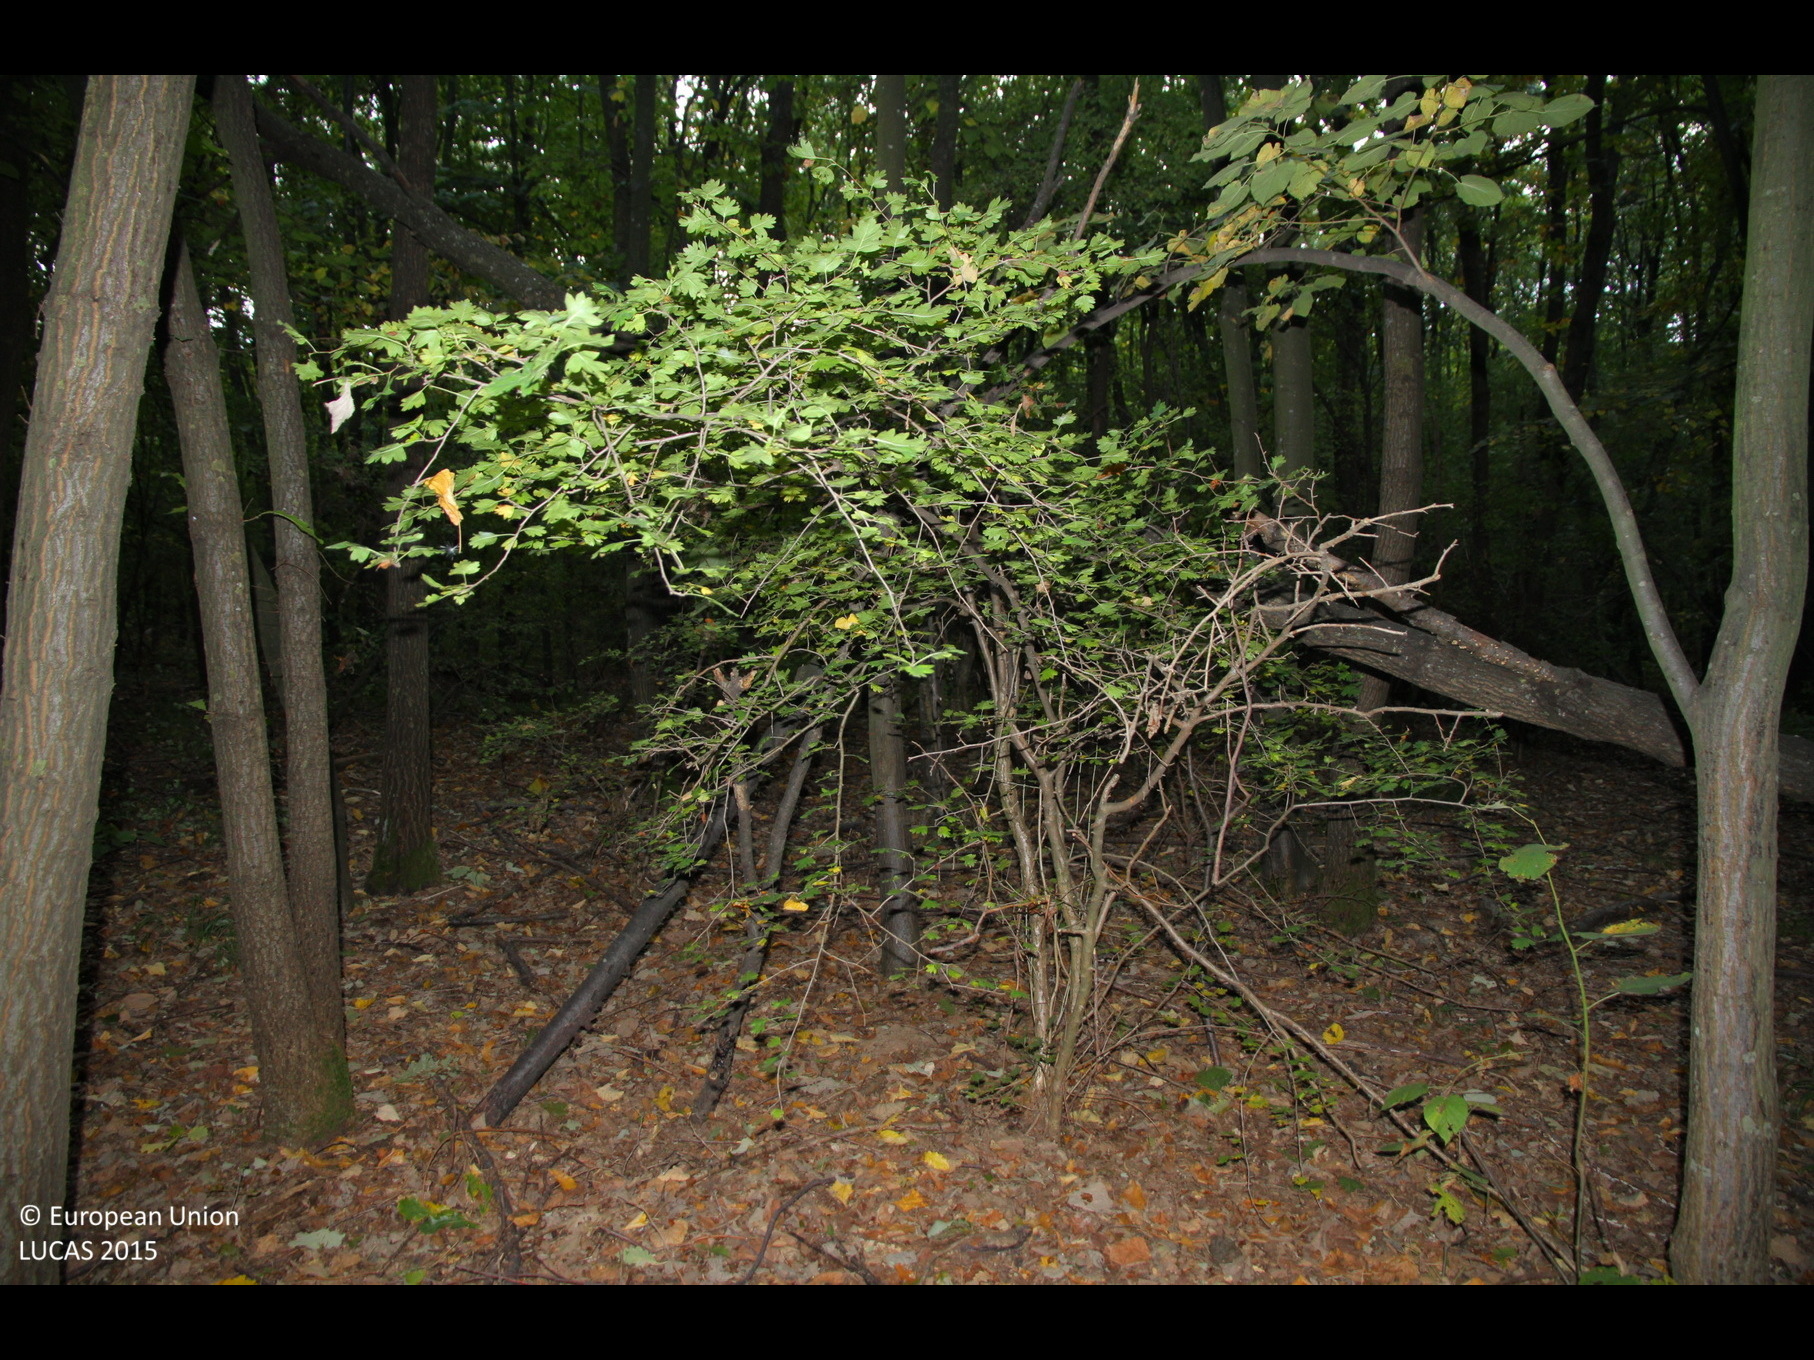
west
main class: Woodland
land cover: Broadleaved woodland
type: beech forest
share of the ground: > 75 %
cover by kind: broadleaved forest trees 100 %
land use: Forestry
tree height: > 5 m
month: October
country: BG
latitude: 43.5470
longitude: 27.1911
